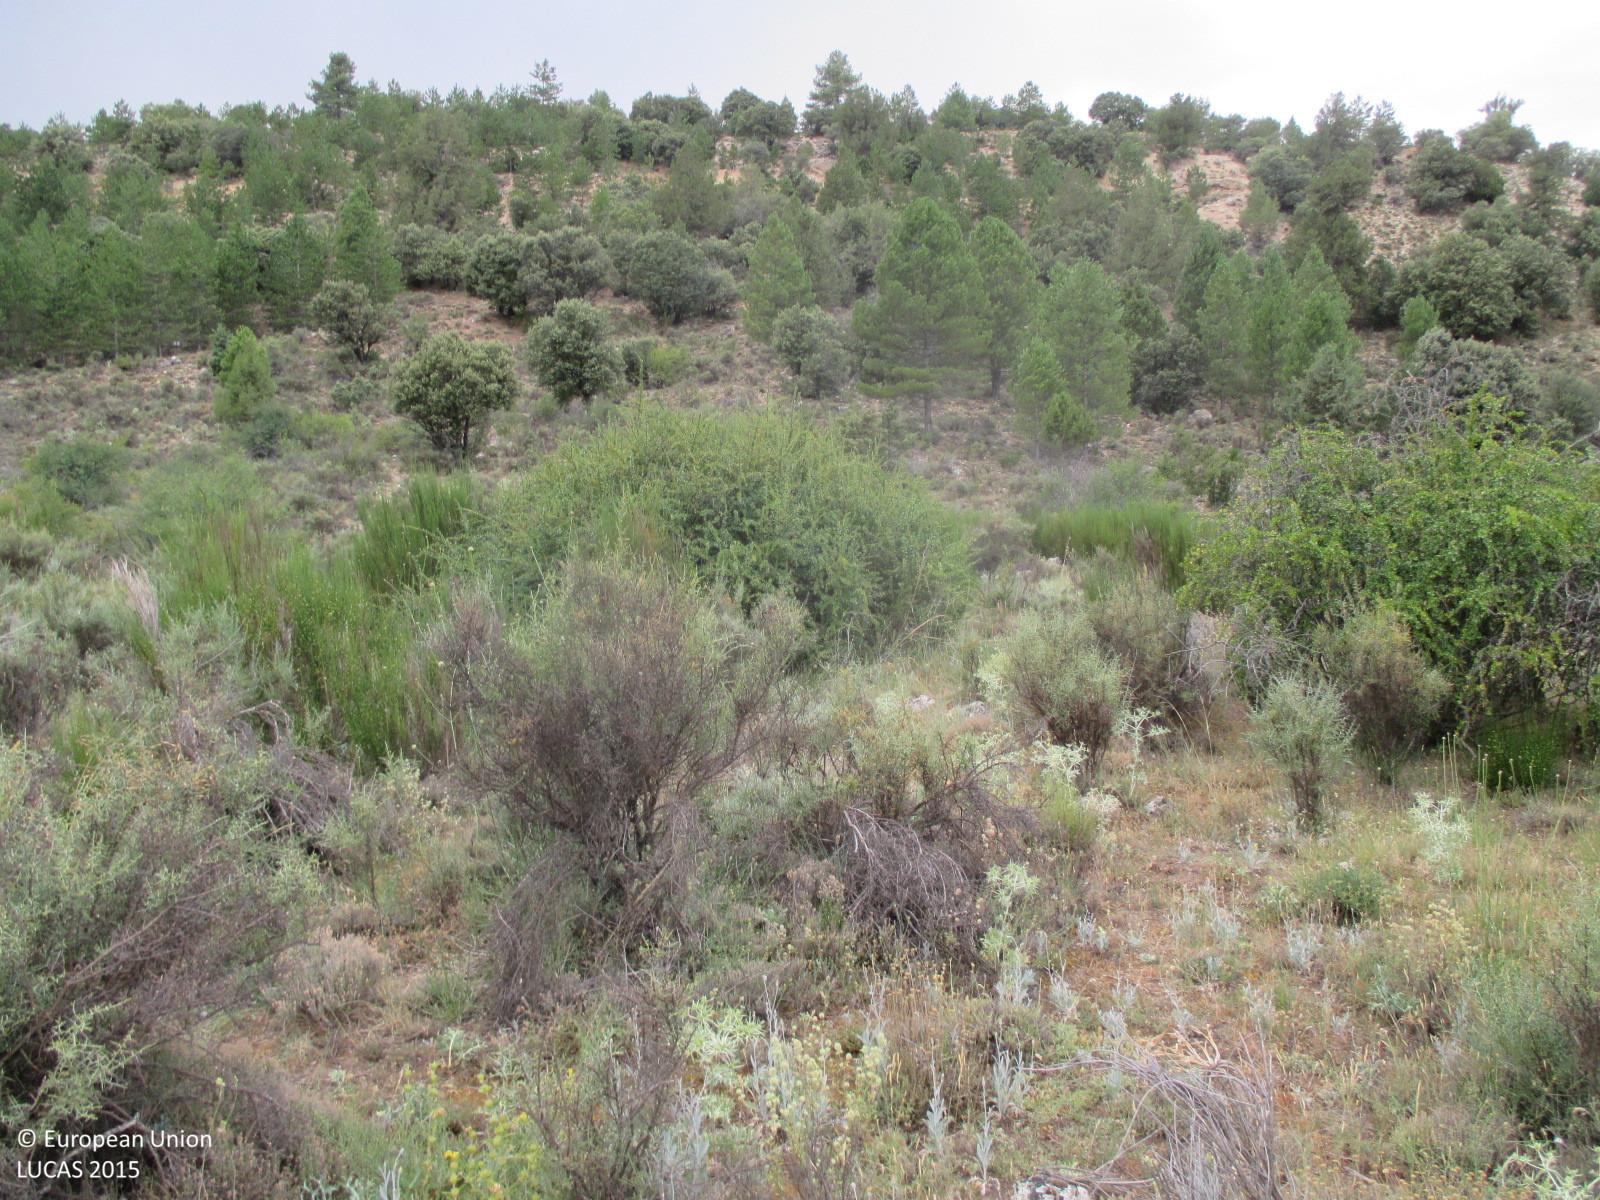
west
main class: Shrubland
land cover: Shrubland without tree cover
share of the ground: 50 - 75 %
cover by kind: shrubs 50 %, herbaceous plants 50 %
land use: Semi-natural and natural areas not in use
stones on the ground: < 10 %
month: July
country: ES
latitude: 38.1243
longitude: -2.3929
